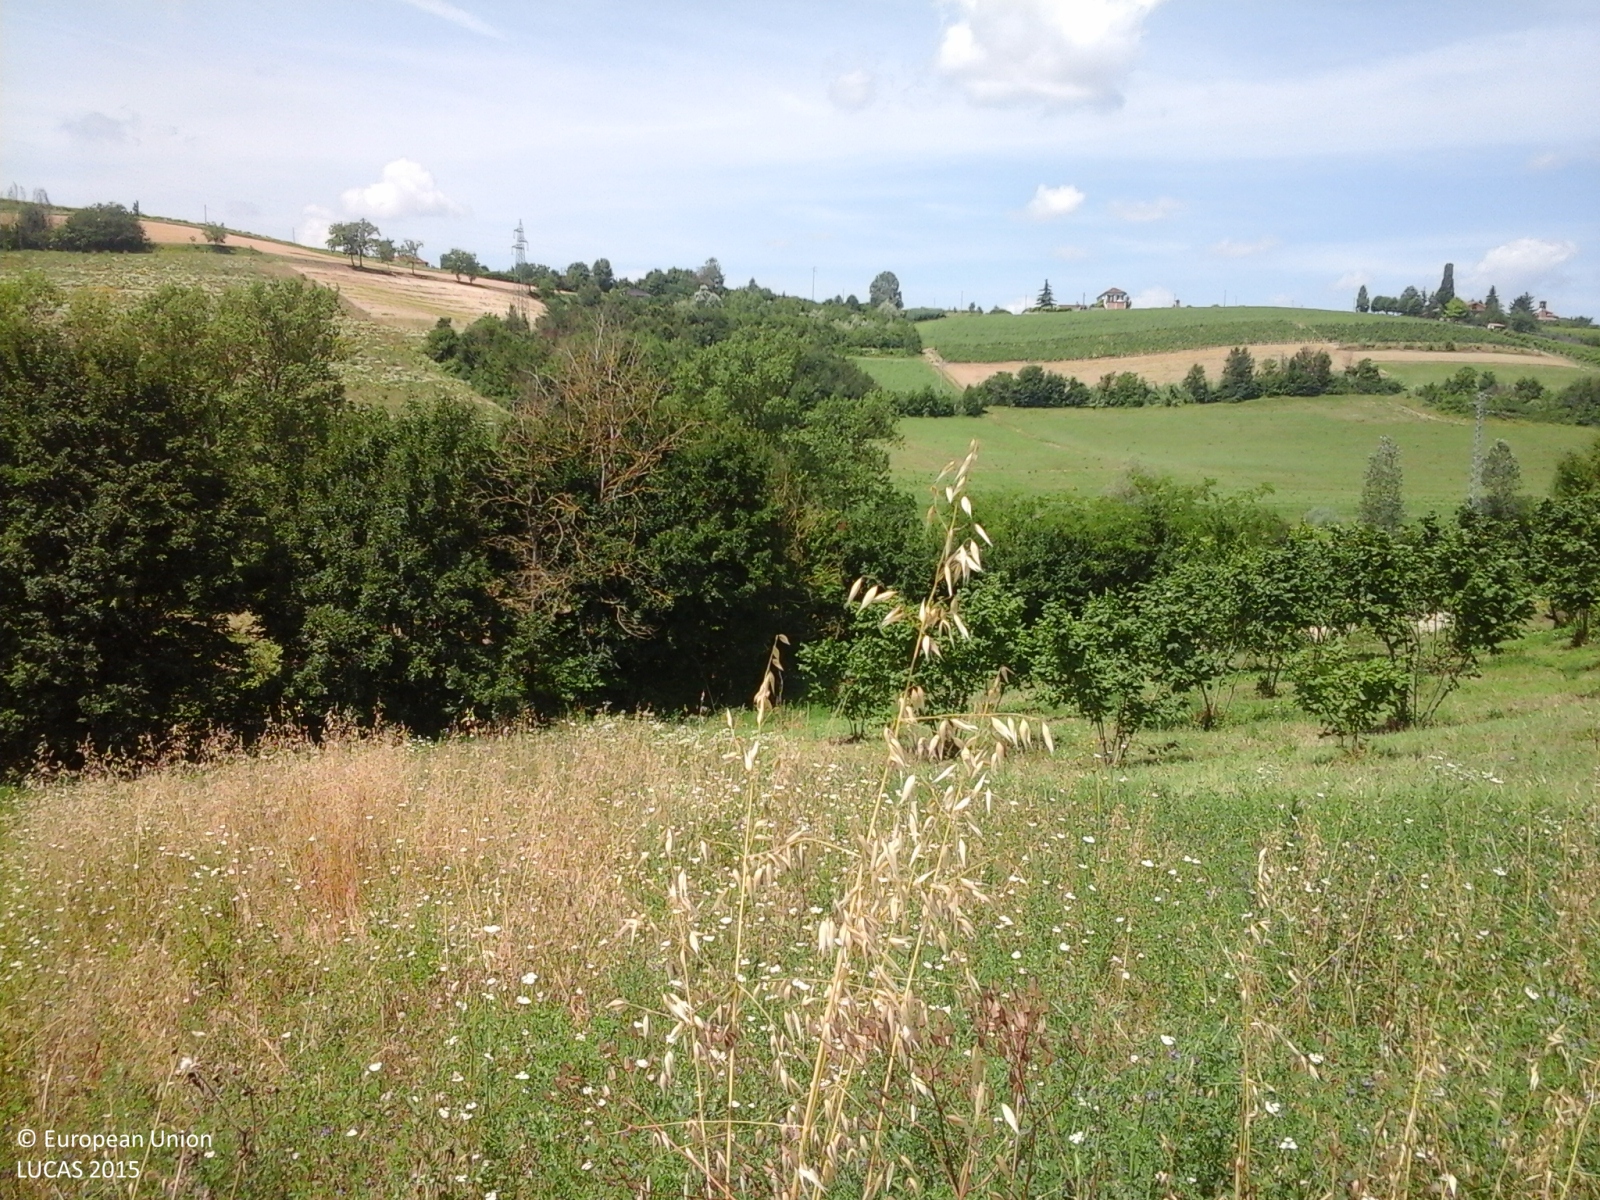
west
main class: Cropland
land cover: Temporary grasslands
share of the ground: > 75 %
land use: Agriculture (excluding fallow land and kitchen gardens)
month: June
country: IT
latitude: 45.0218
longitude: 8.2899
